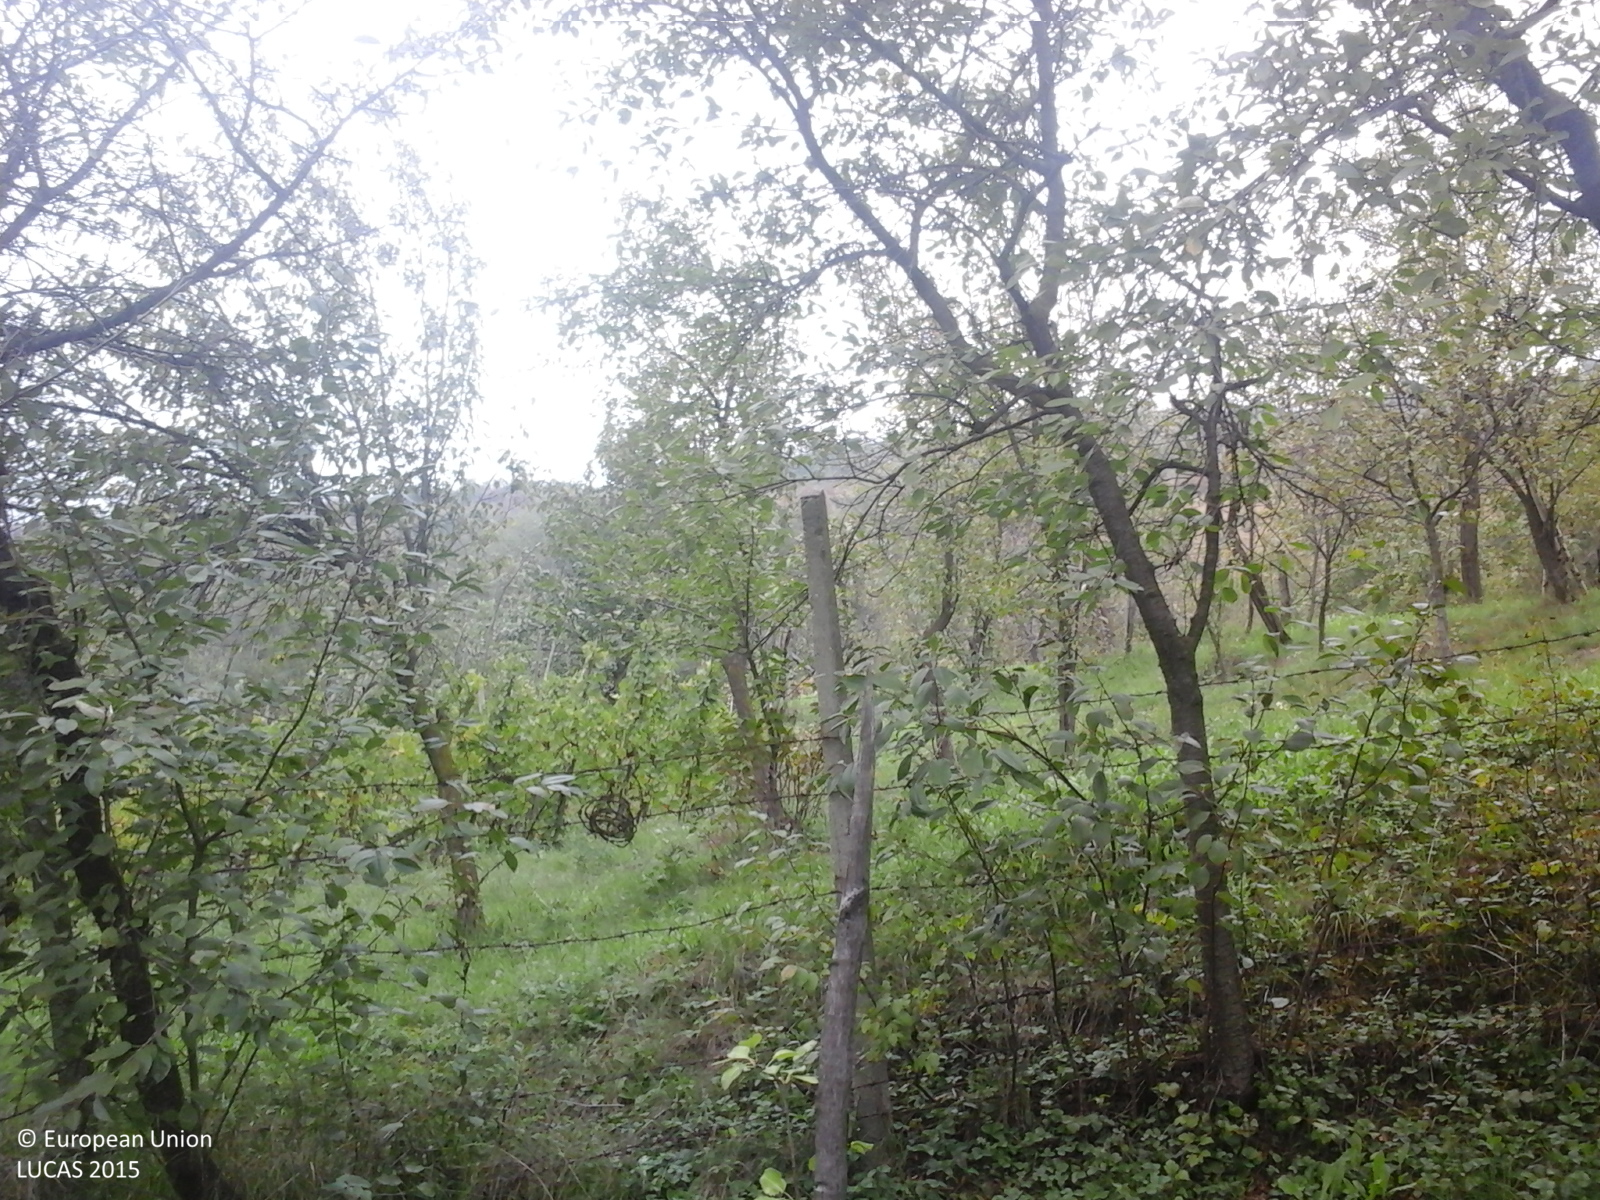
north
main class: Cropland
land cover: Nuts trees
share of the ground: > 75 %
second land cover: Grassland without tree/shrub cover
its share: > 75 %
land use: Agriculture (excluding fallow land and kitchen gardens)
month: October
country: RO
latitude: 46.1665
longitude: 23.4960
